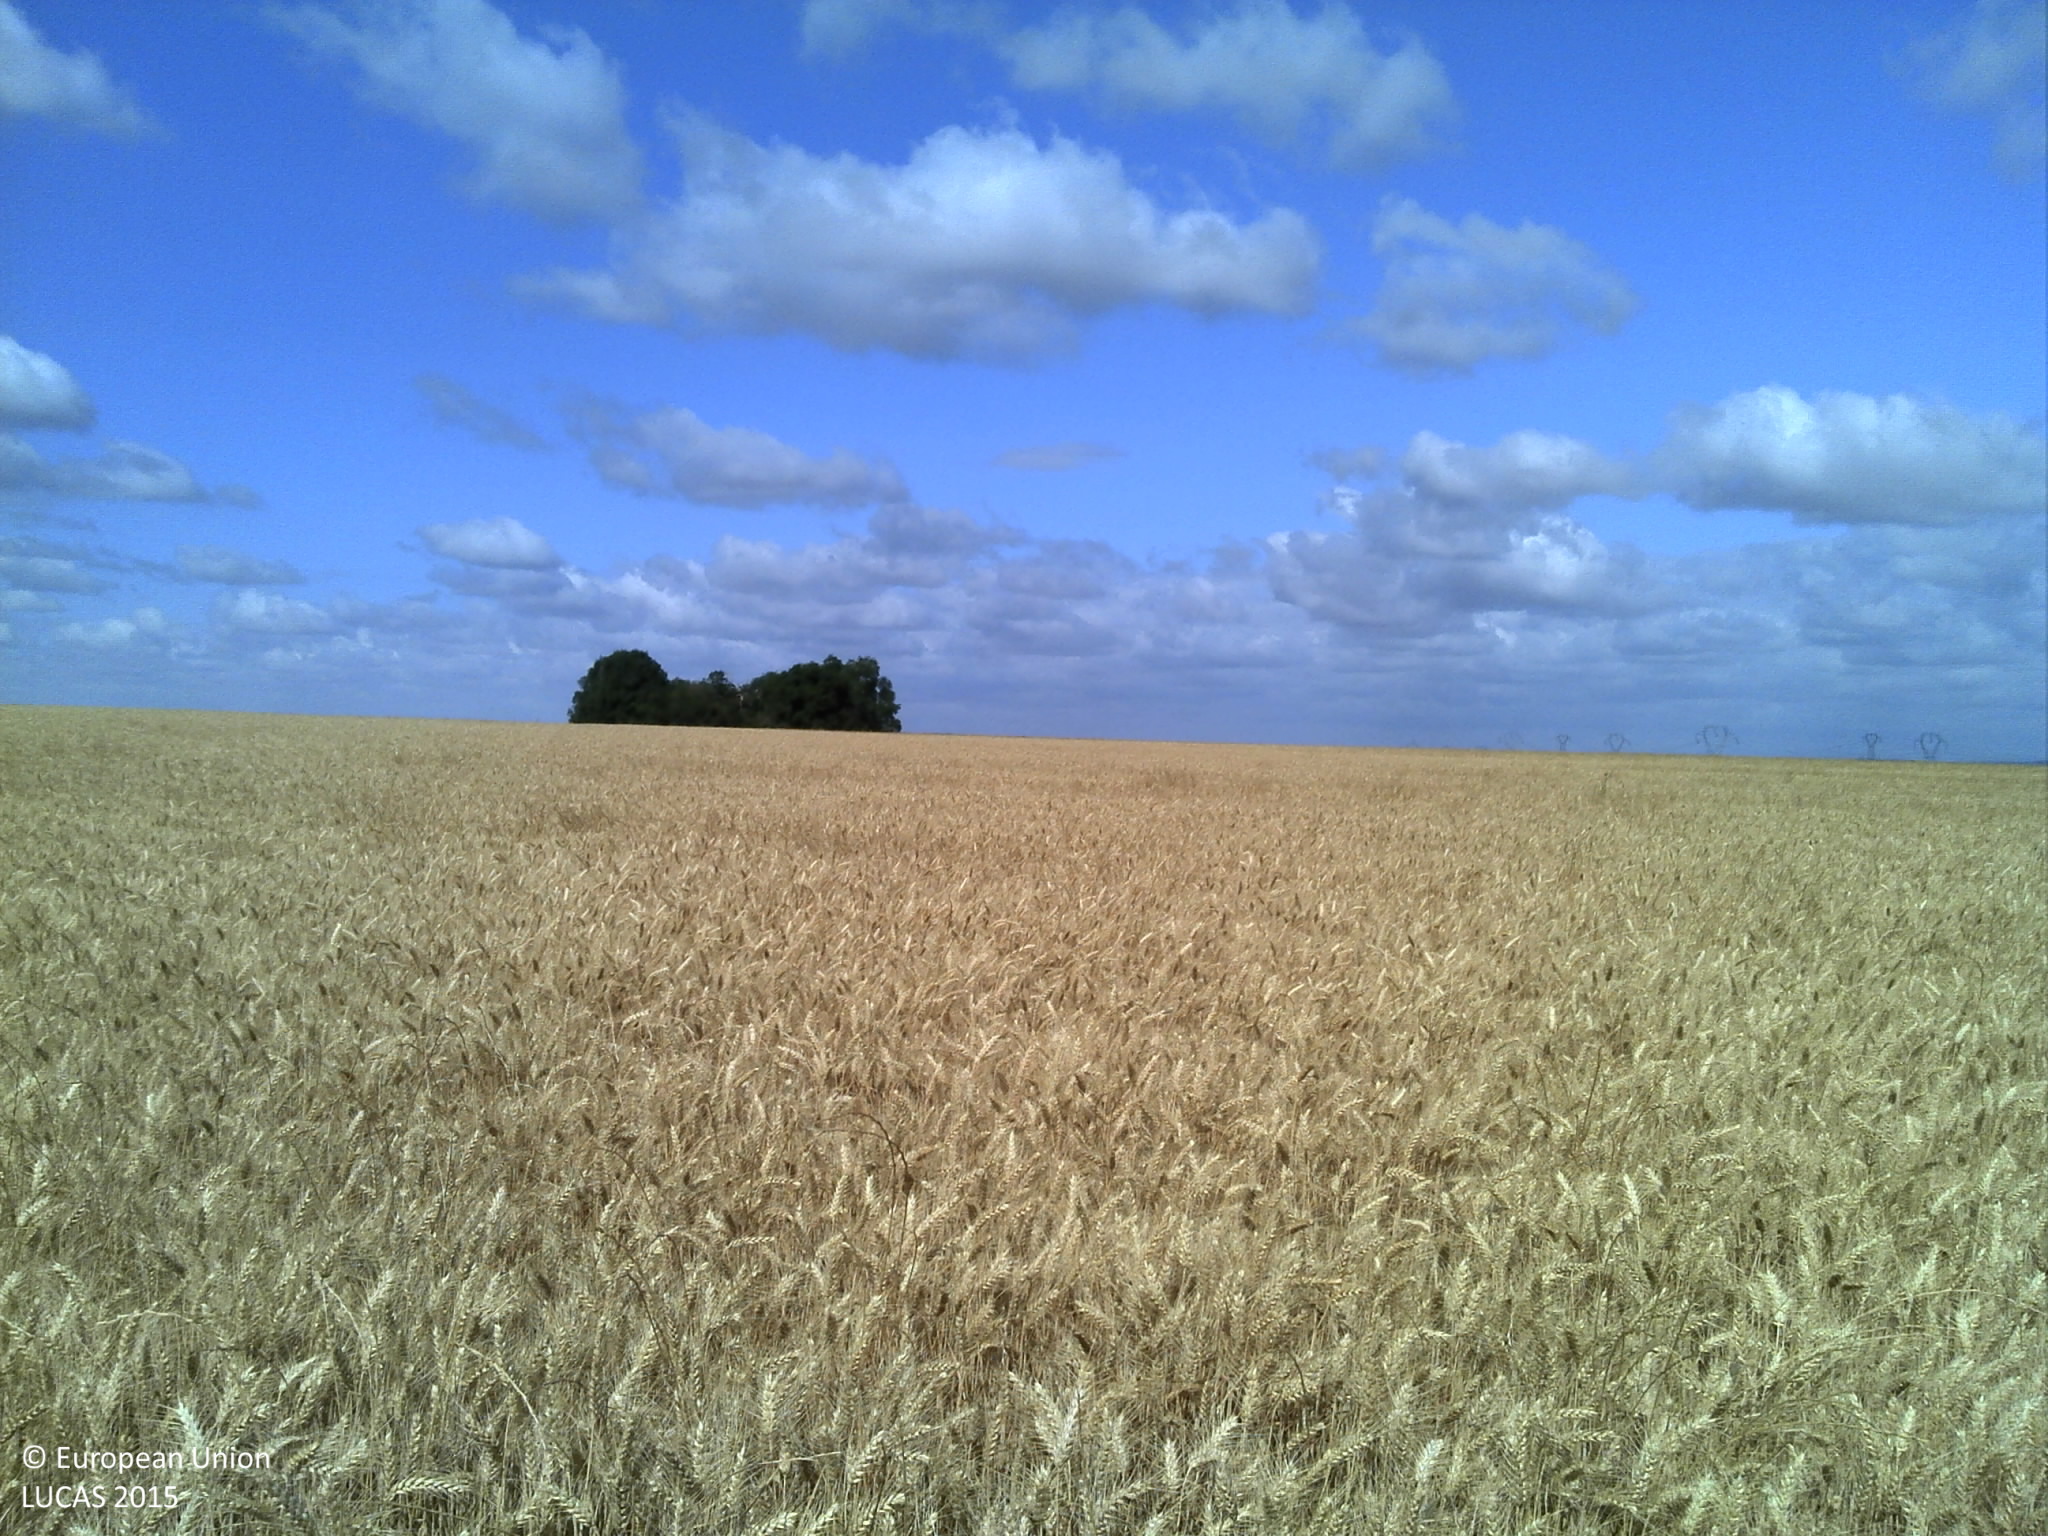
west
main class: Cropland
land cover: Durum wheat
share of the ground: > 75 %
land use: Agriculture (excluding fallow land and kitchen gardens)
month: July
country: FR
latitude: 48.5405
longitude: 2.4175
